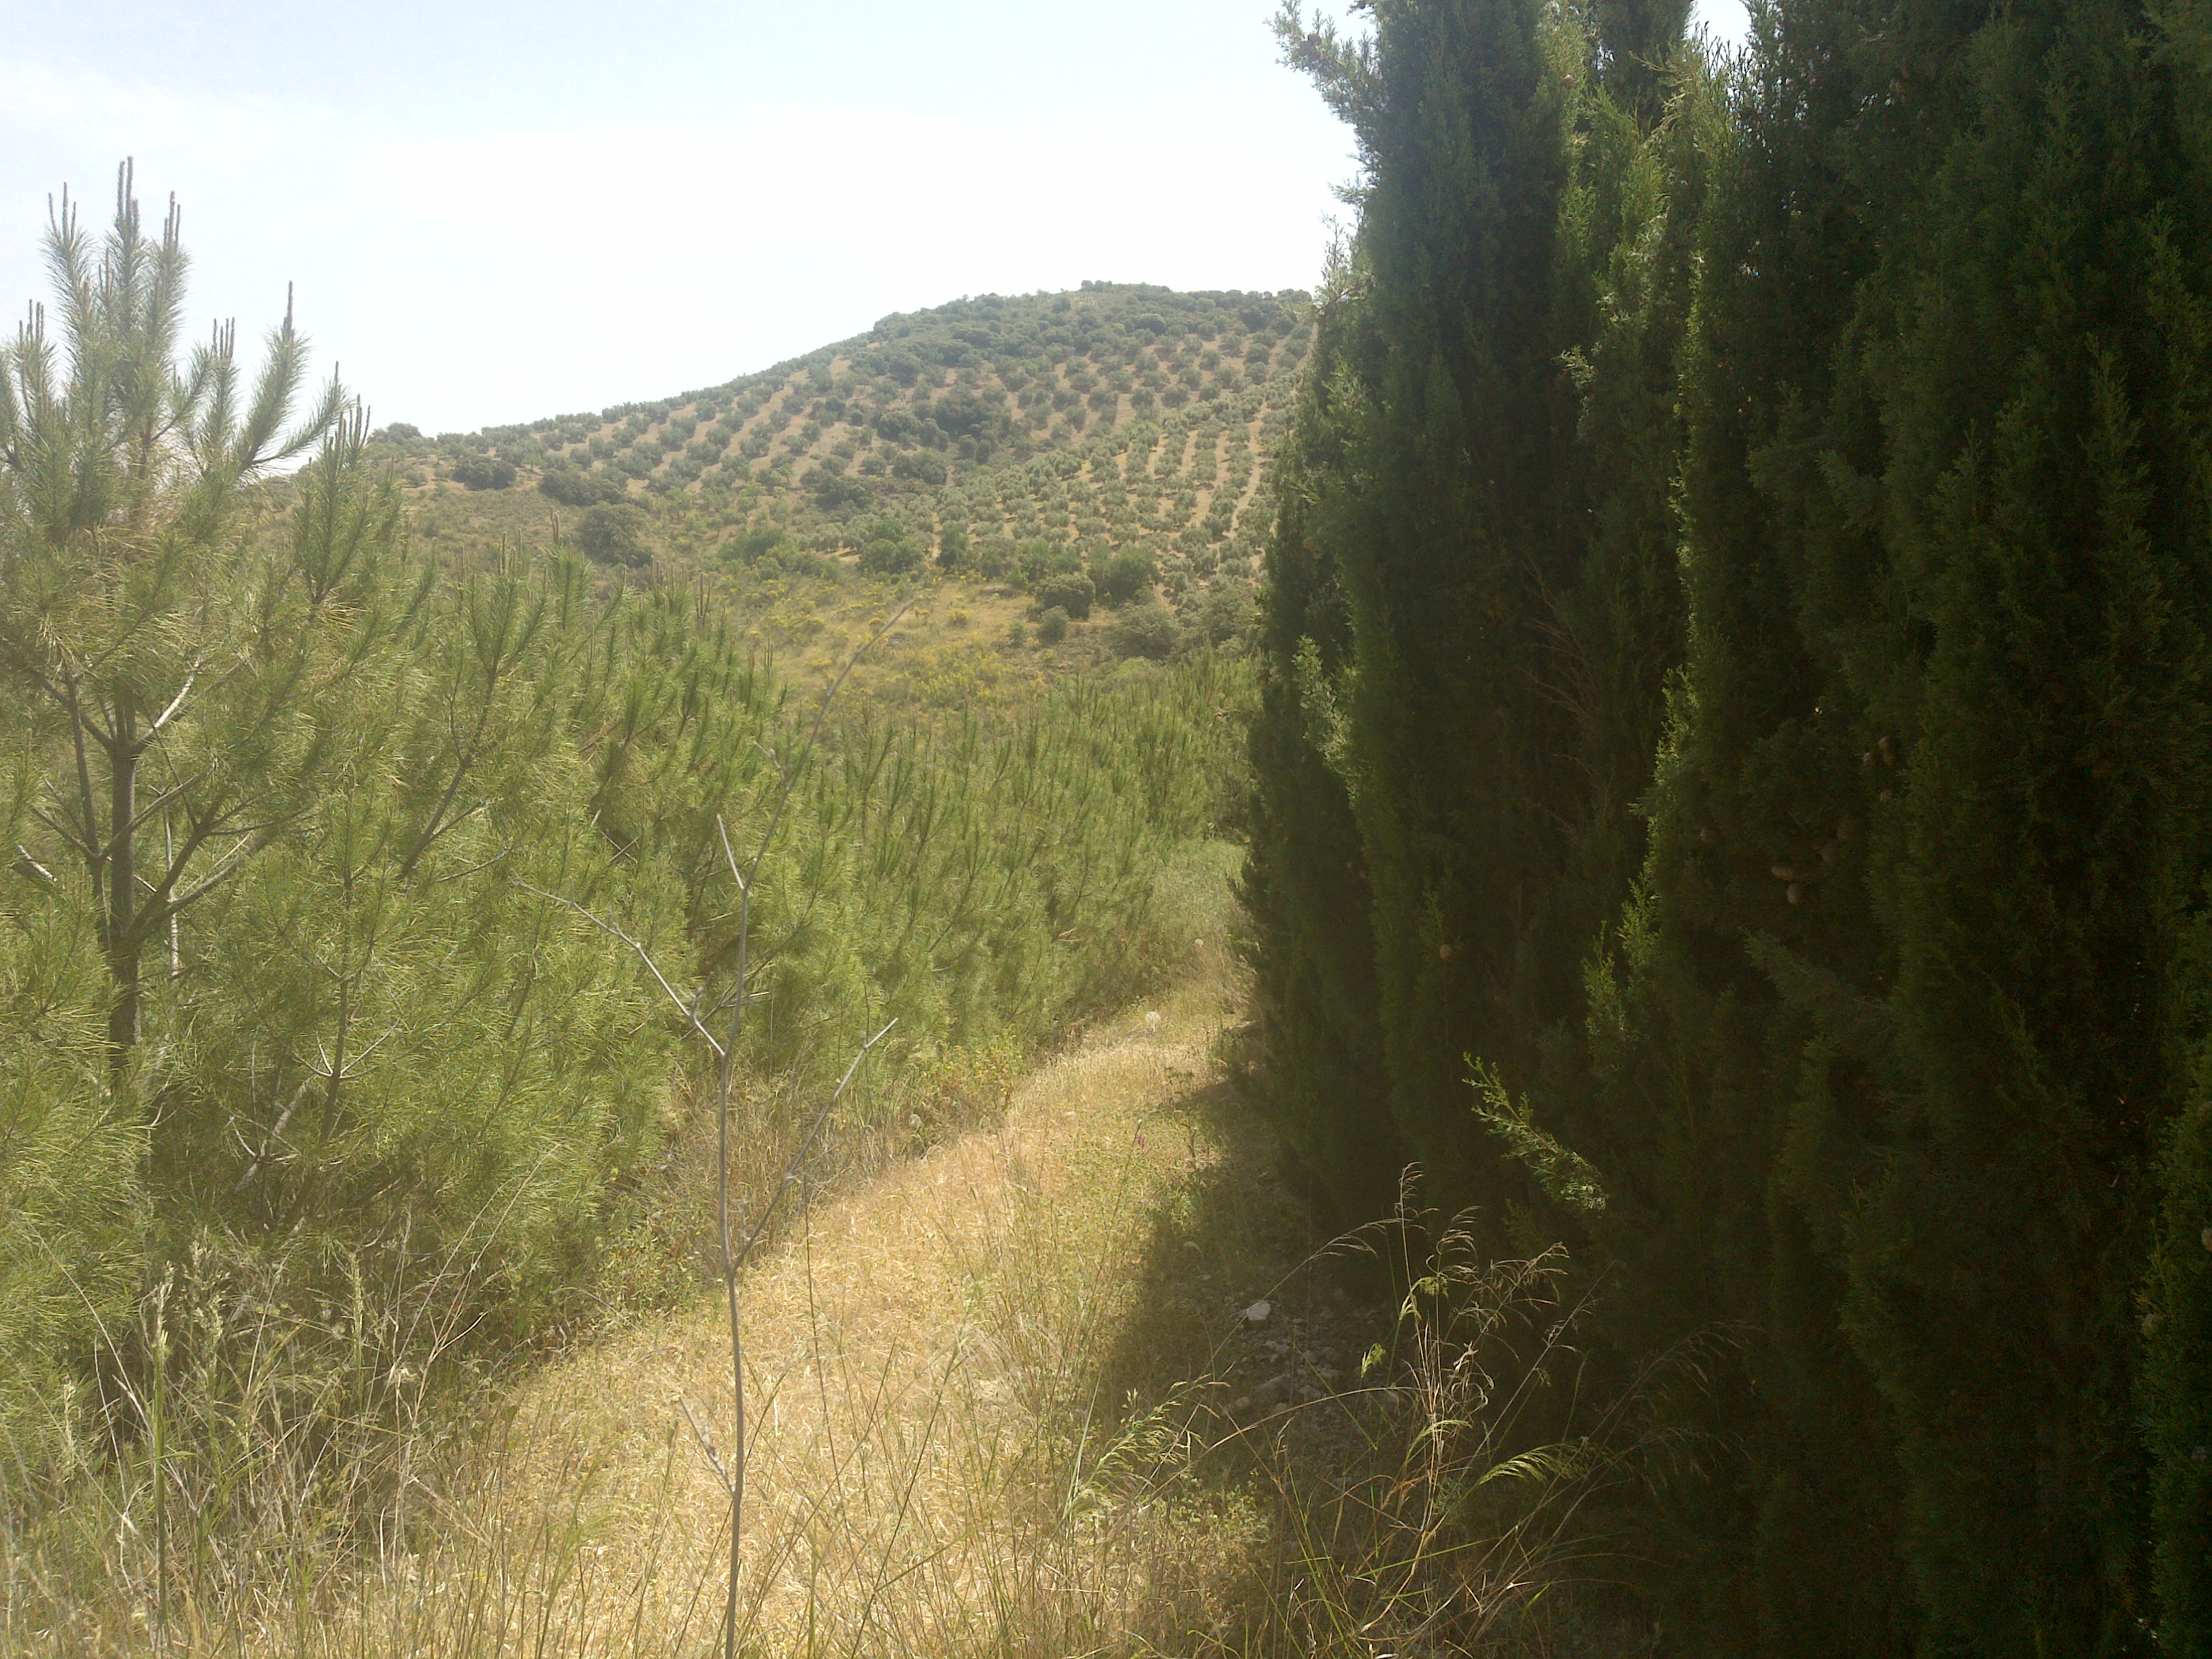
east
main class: Shrubland
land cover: Shrubland without tree cover
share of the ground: 25 - 50 %
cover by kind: herbaceous plants 70 %, shrubs 25 %, unconsolidated bare surface 5 %
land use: Semi-natural and natural areas not in use
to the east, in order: Shrubland without tree cover; Shrubland with sparse tree cover; Olive groves
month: May
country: ES
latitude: 37.4111
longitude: -4.2011
